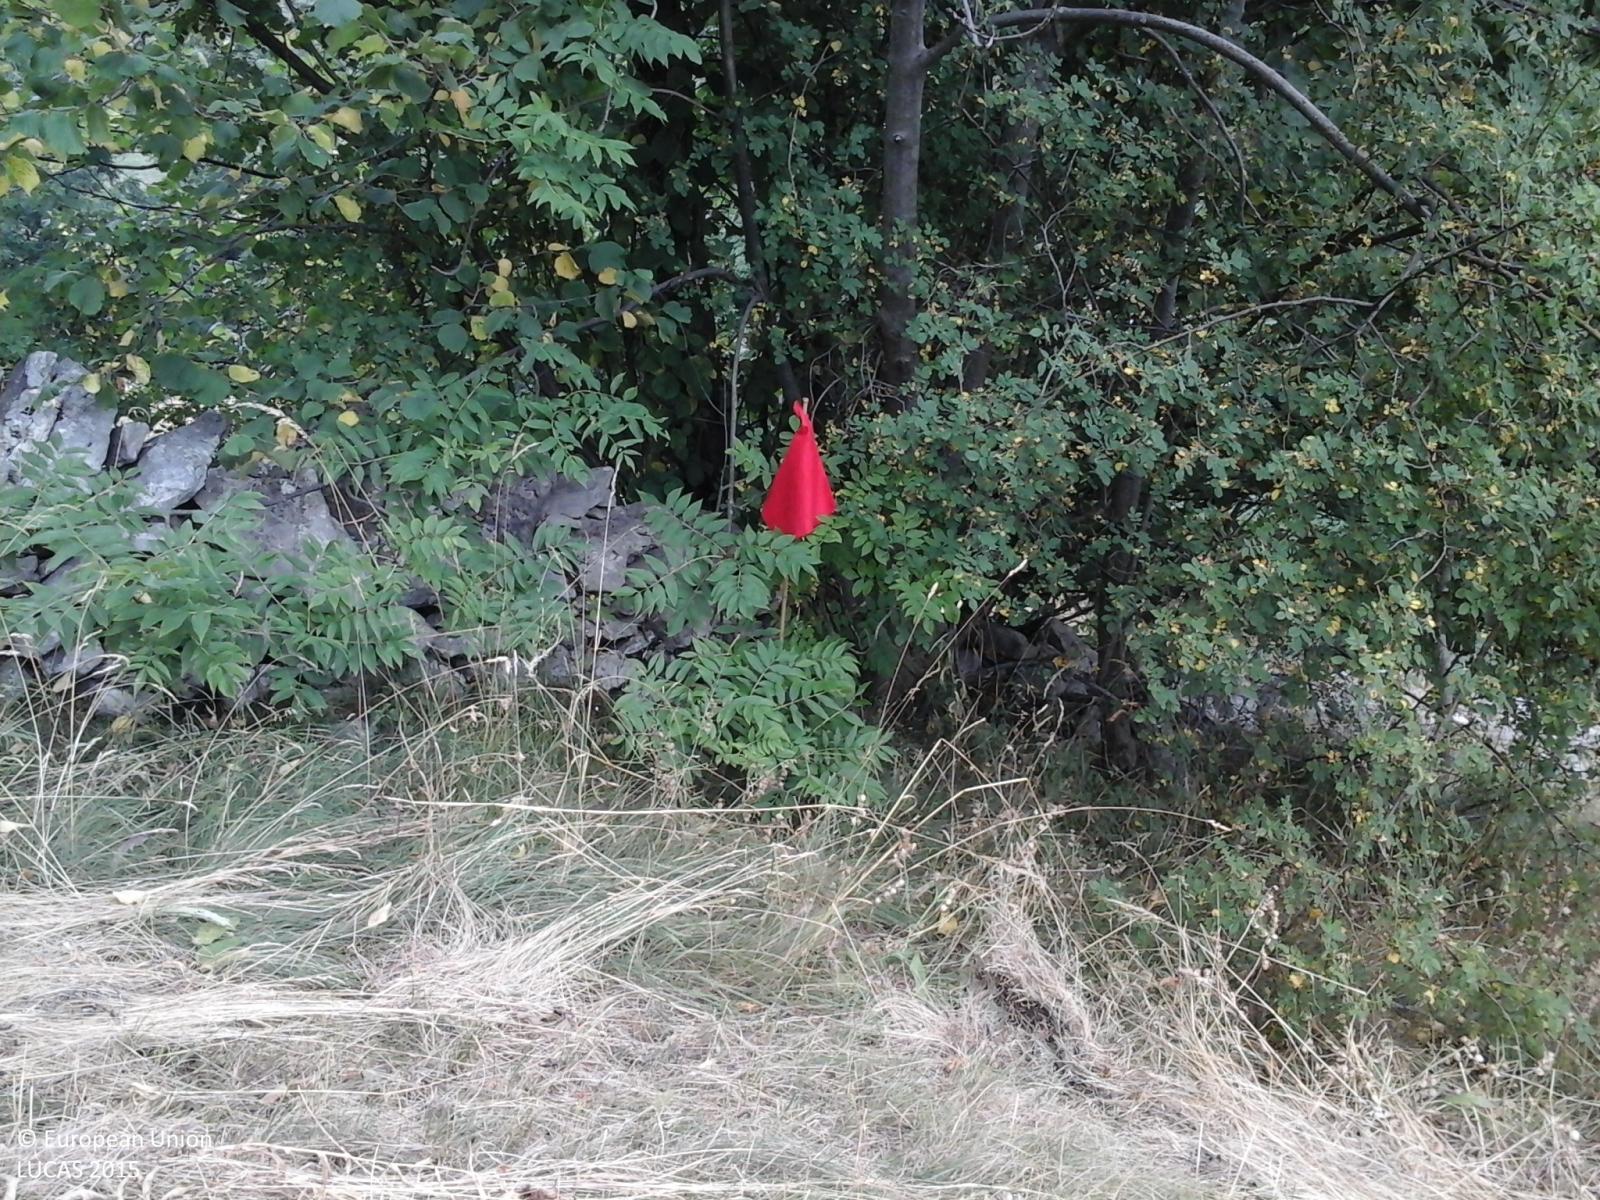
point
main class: Woodland
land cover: Broadleaved woodland
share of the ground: > 75 %
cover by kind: broadleaved forest trees 100 %
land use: Forestry
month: July
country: IT
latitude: 45.6247
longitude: 11.1141
